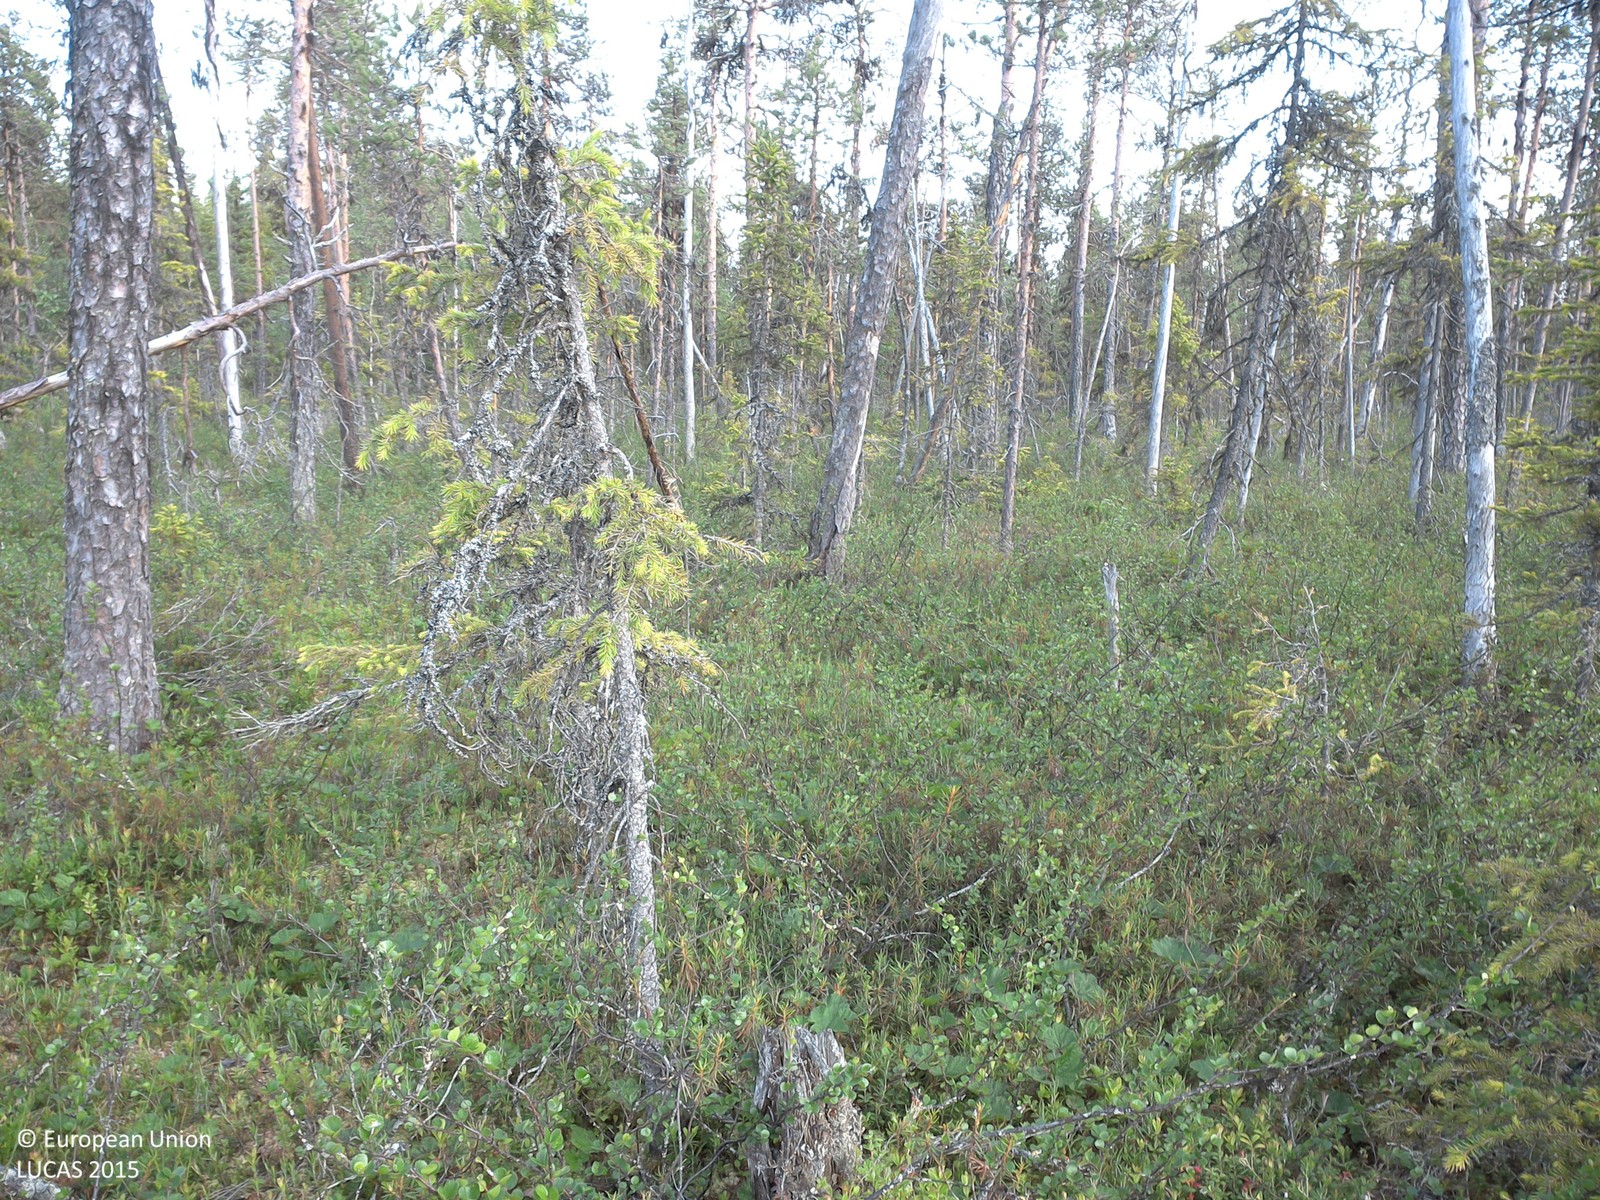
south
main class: Woodland
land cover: Pine dominated coniferous woodland
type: boreal forest
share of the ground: 10 - 25 %
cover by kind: shrubs 40 %, lichens and mosses 25 %, herbaceous plants 20 %, coniferous forest trees 15 %
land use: Semi-natural and natural areas not in use
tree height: > 5 m
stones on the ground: < 10 %
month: July
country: SE
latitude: 67.0761
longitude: 22.7815
